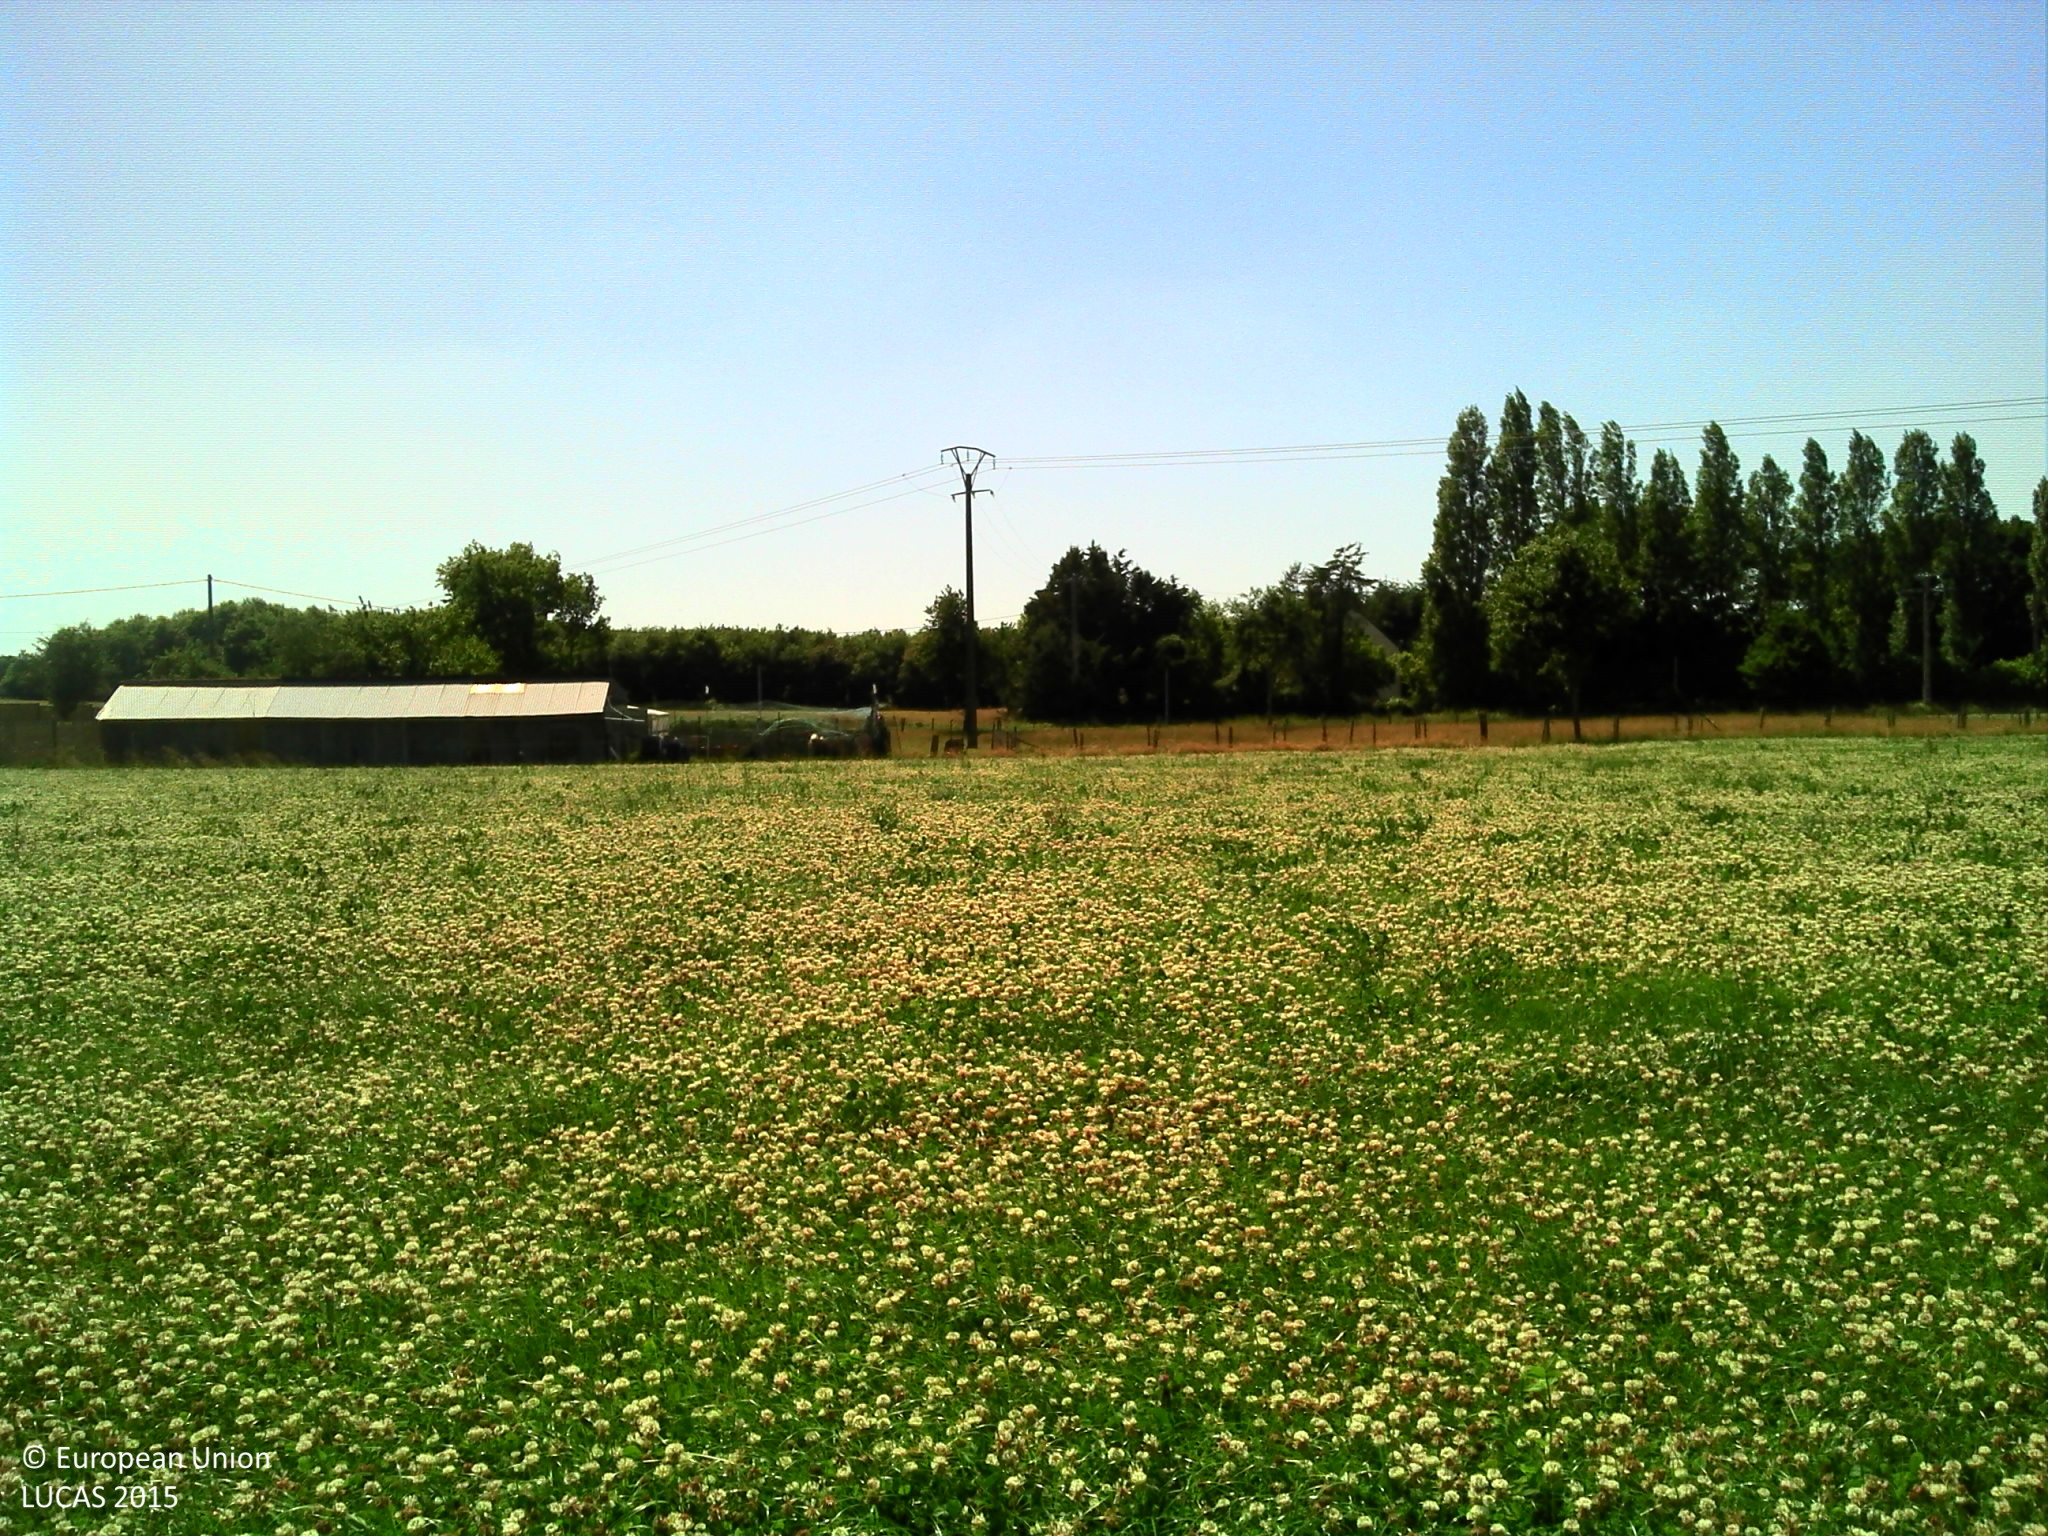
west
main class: Cropland
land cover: Clovers
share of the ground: > 75 %
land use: Agriculture (excluding fallow land and kitchen gardens)
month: June
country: FR
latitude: 48.0136
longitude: -1.7249
